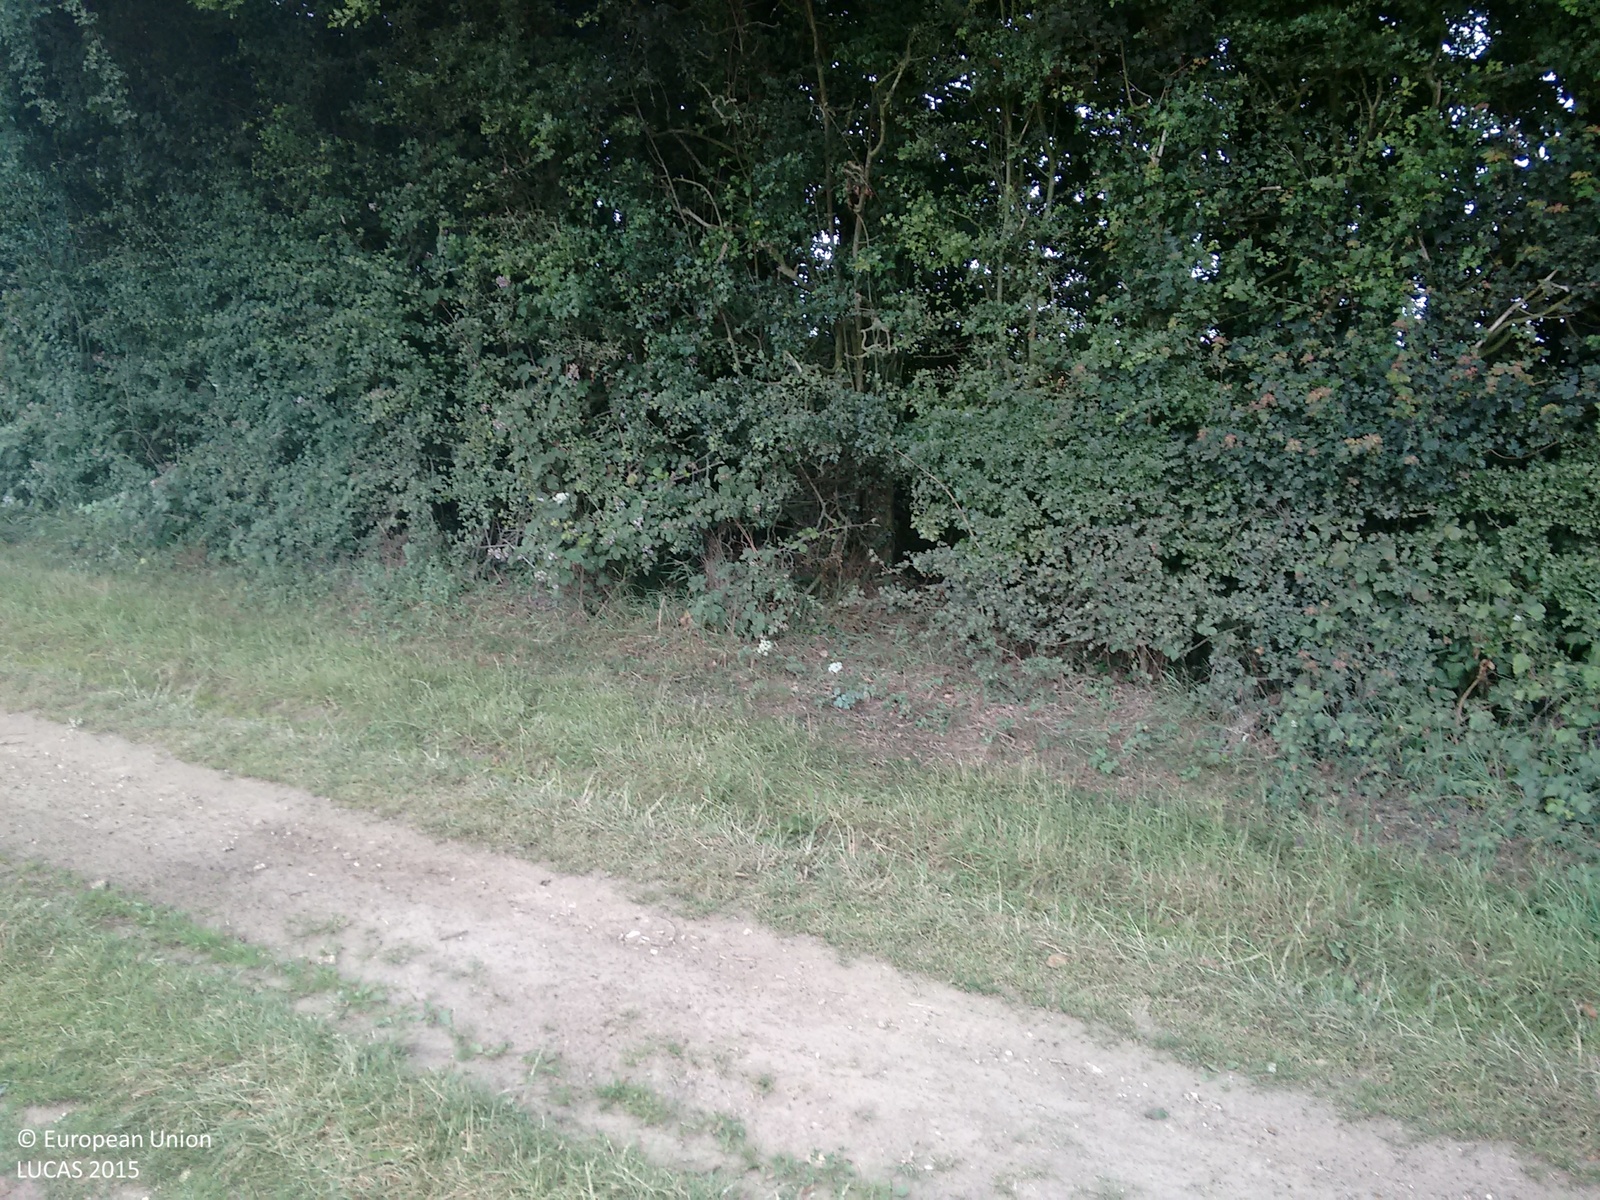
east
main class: Cropland
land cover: Barley
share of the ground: > 75 %
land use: Agriculture (excluding fallow land and kitchen gardens)
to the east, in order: Barley; Grass margins; Tracks; Grass margins; Broadleaved woodland; Grass margins; Other fibre and oleaginous crops; Barley
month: July
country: GB
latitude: 51.0207
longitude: -1.0940
